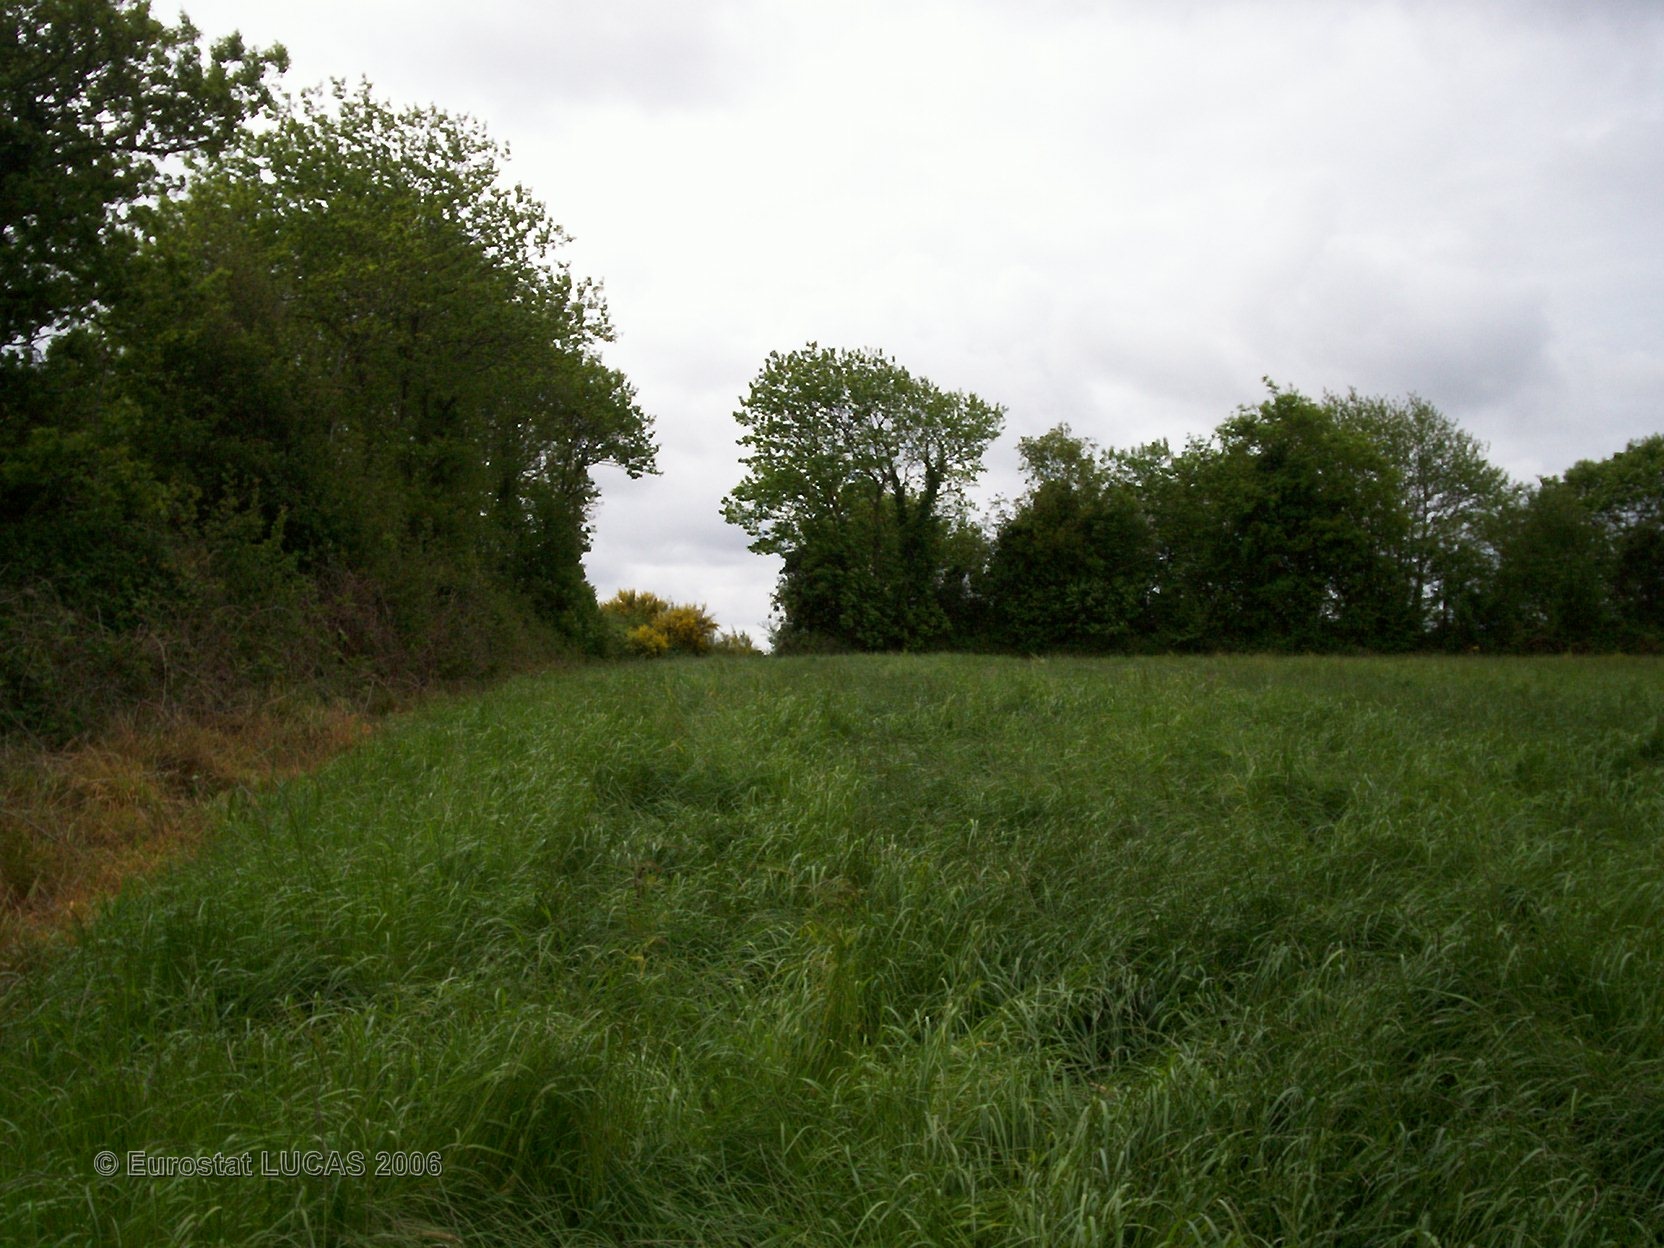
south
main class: Grassland
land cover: Grassland without tree/shrub cover
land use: Agriculture (excluding fallow land and kitchen gardens)
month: May
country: FR
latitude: 47.9771
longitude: -3.8960
